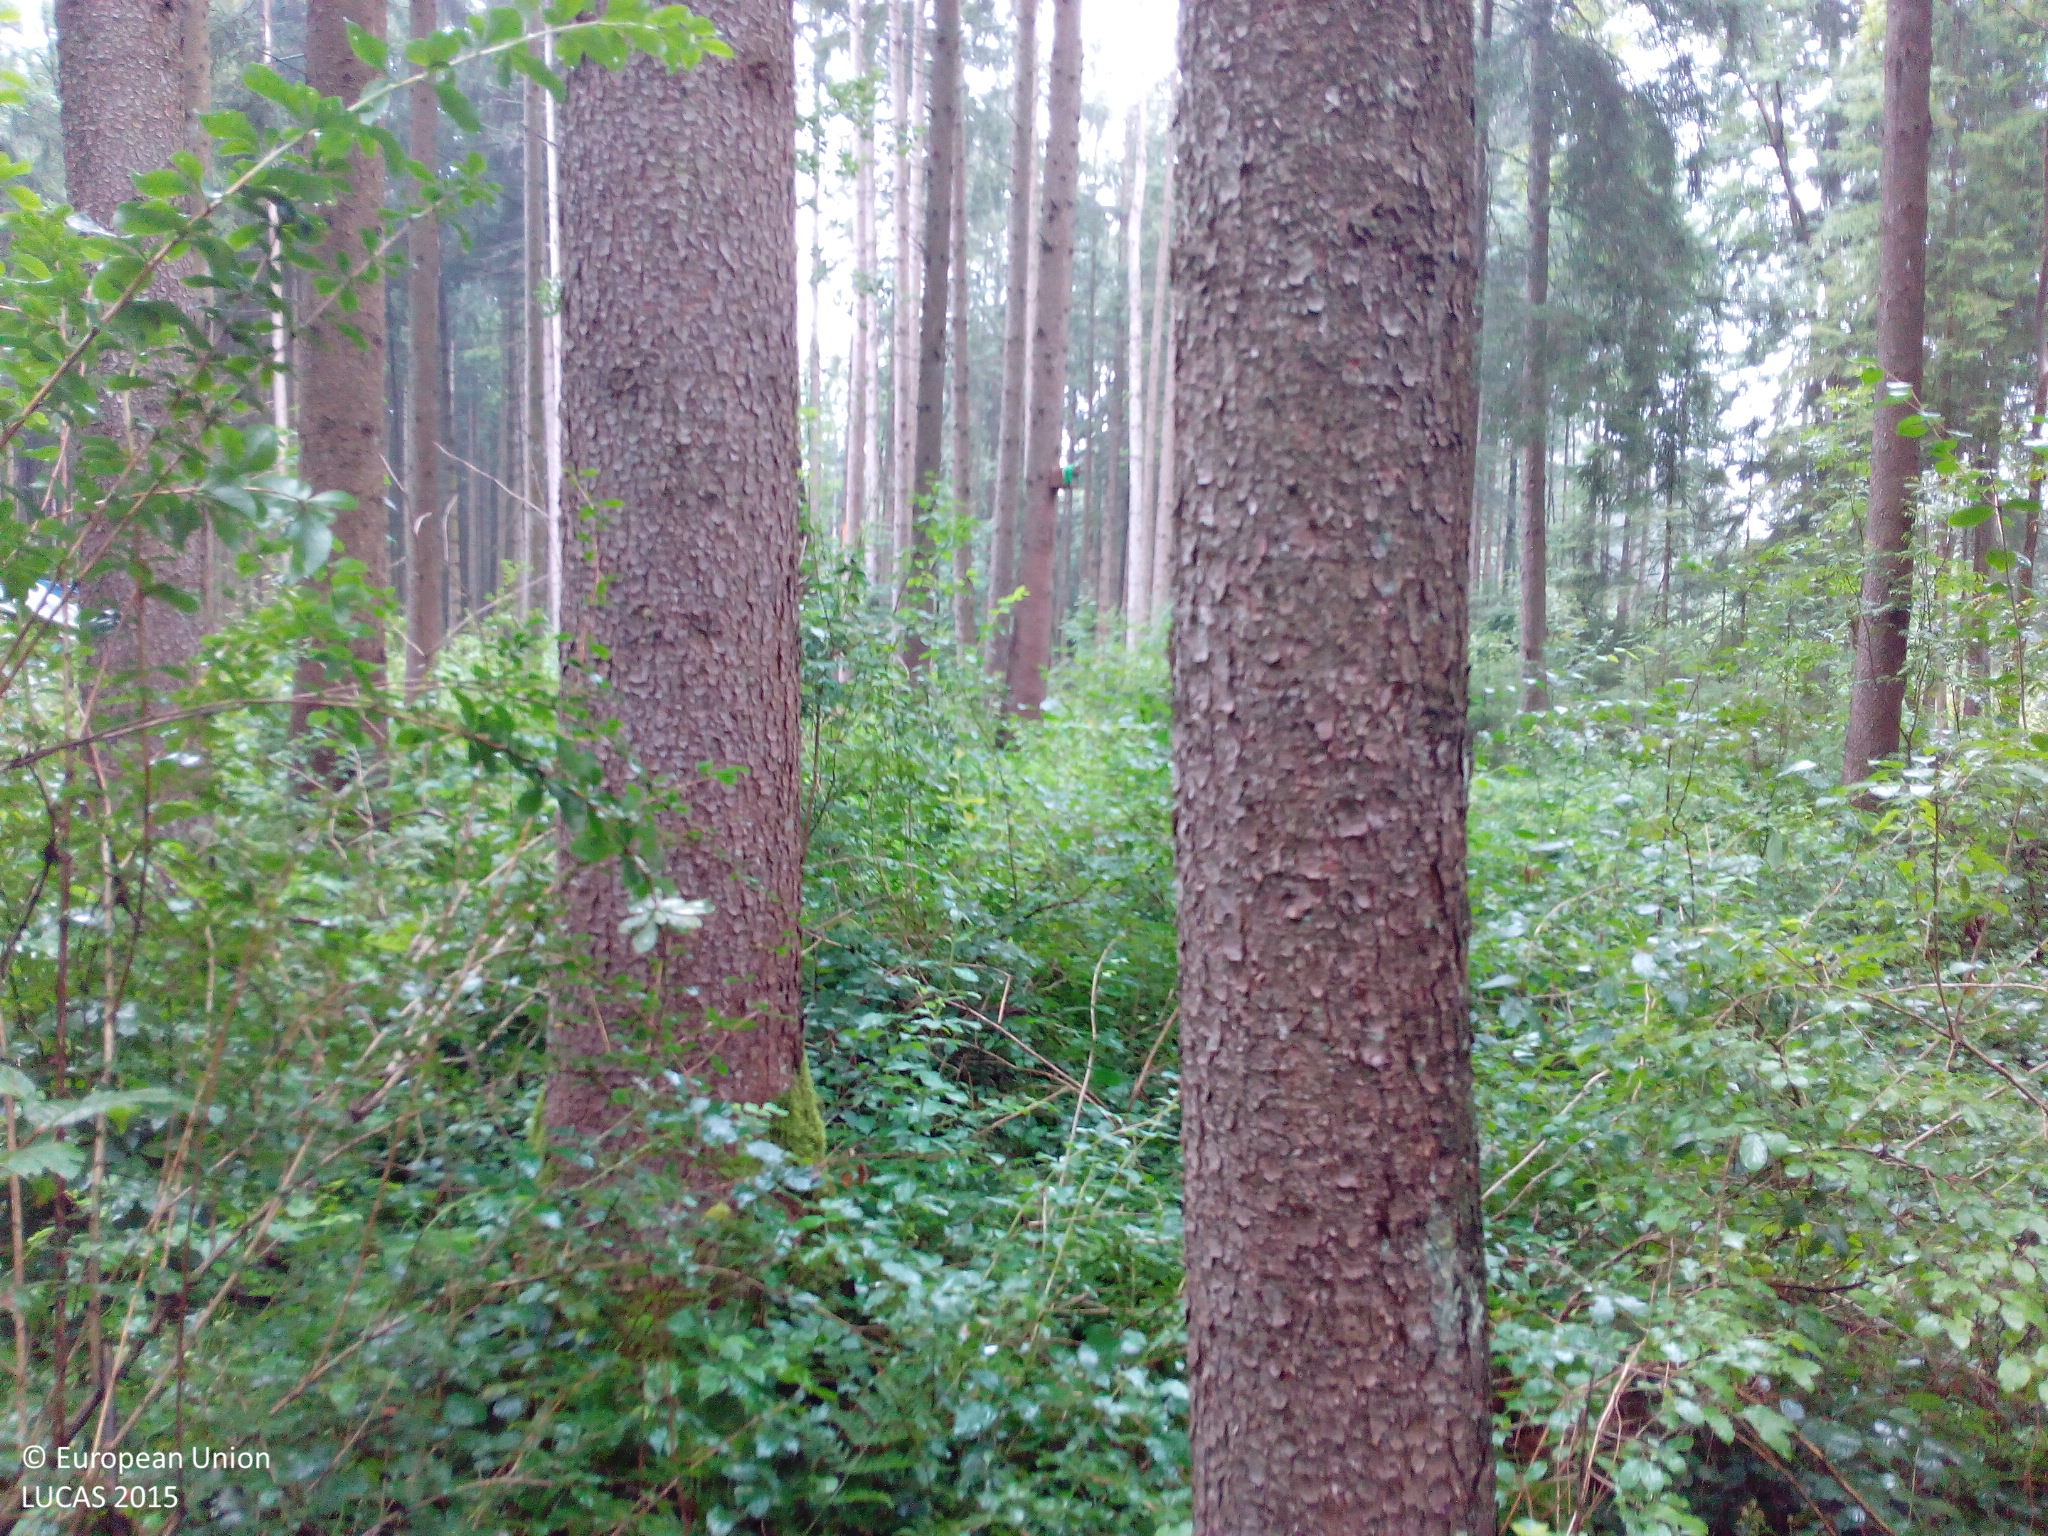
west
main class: Woodland
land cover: Spruce dominated coniferous woodland
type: hemiboreal forest and nemoral coniferous forest and mixed broadleaved-coniferous forest
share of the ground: > 75 %
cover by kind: coniferous forest trees 75 %, shrubs 20 %, broadleaved forest trees 5 %
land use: Forestry
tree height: > 5 m
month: August
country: DE
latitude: 47.8980
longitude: 12.8746
